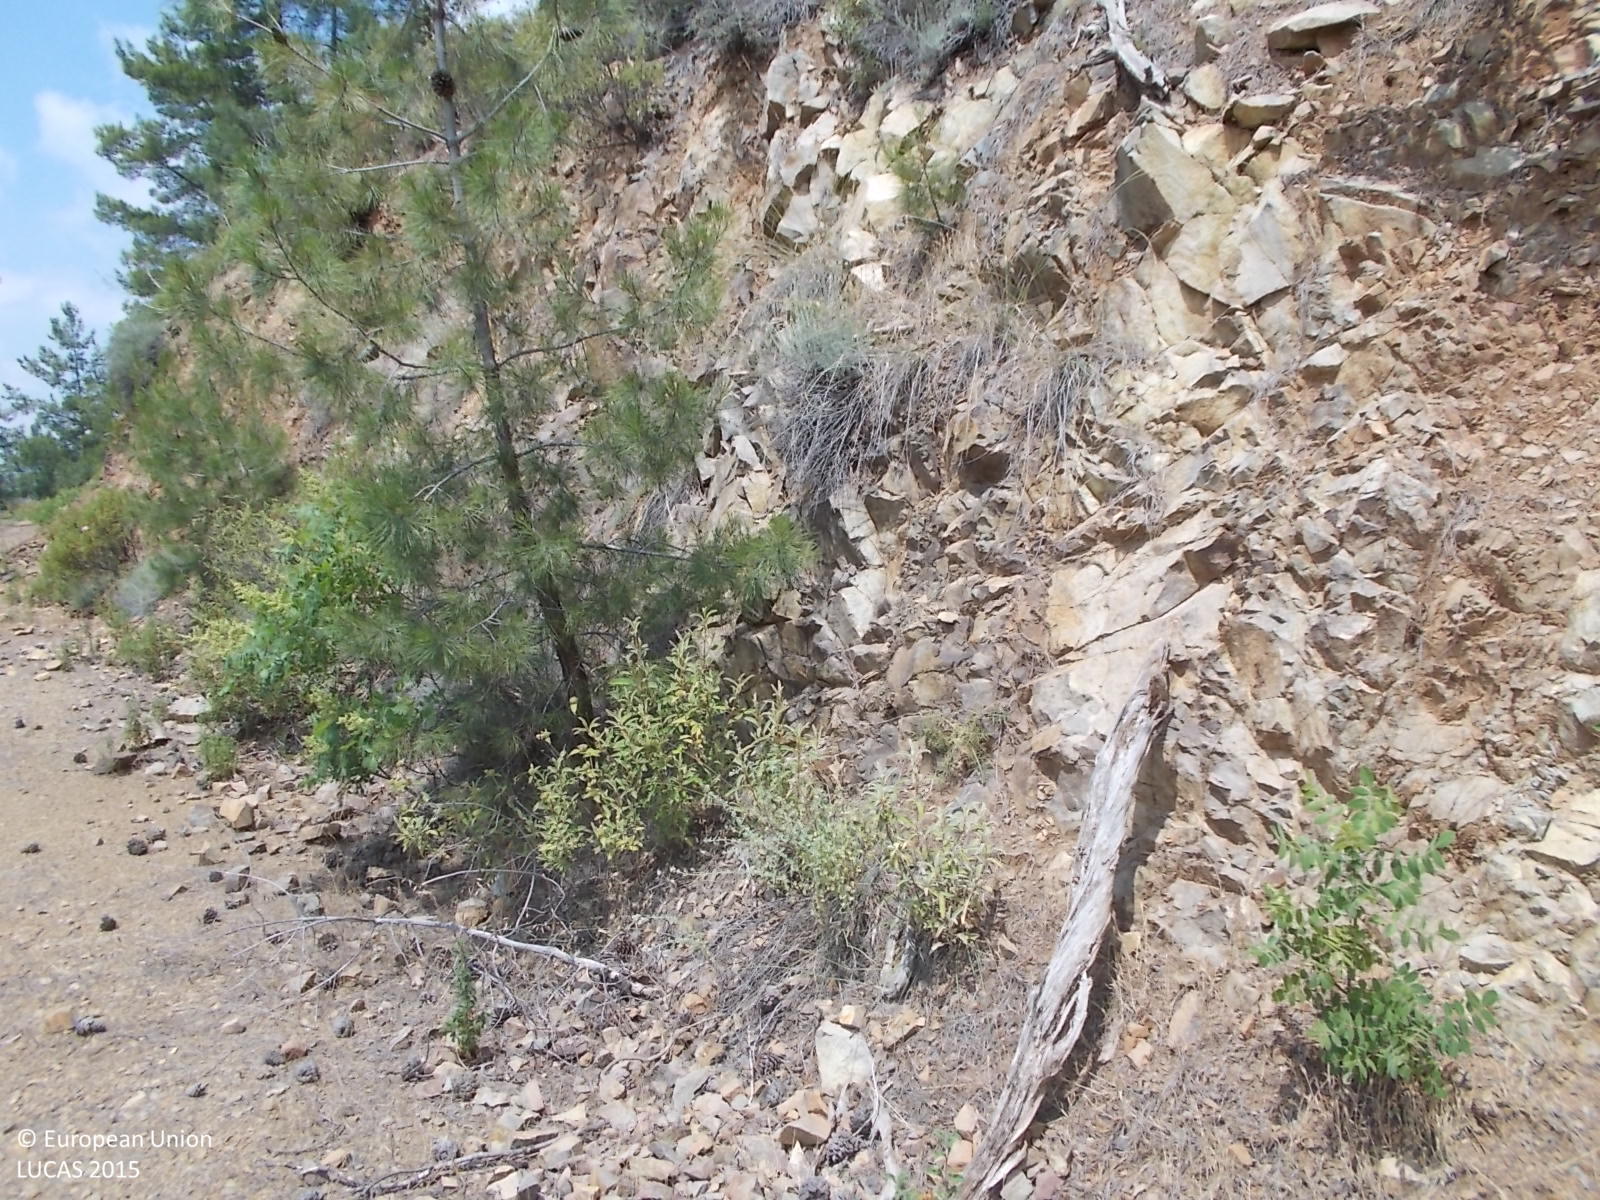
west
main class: Woodland
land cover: Pine dominated mixed woodland
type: coniferous forest of the mediterranean region
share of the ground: 50 - 75 %
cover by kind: coniferous forest trees 40 %, broadleaved forest trees 25 %, shrubs 20 %, unconsolidated bare surface 15 %
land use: Forestry
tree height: > 5 m
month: June
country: CY
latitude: 35.0050
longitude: 32.6109
